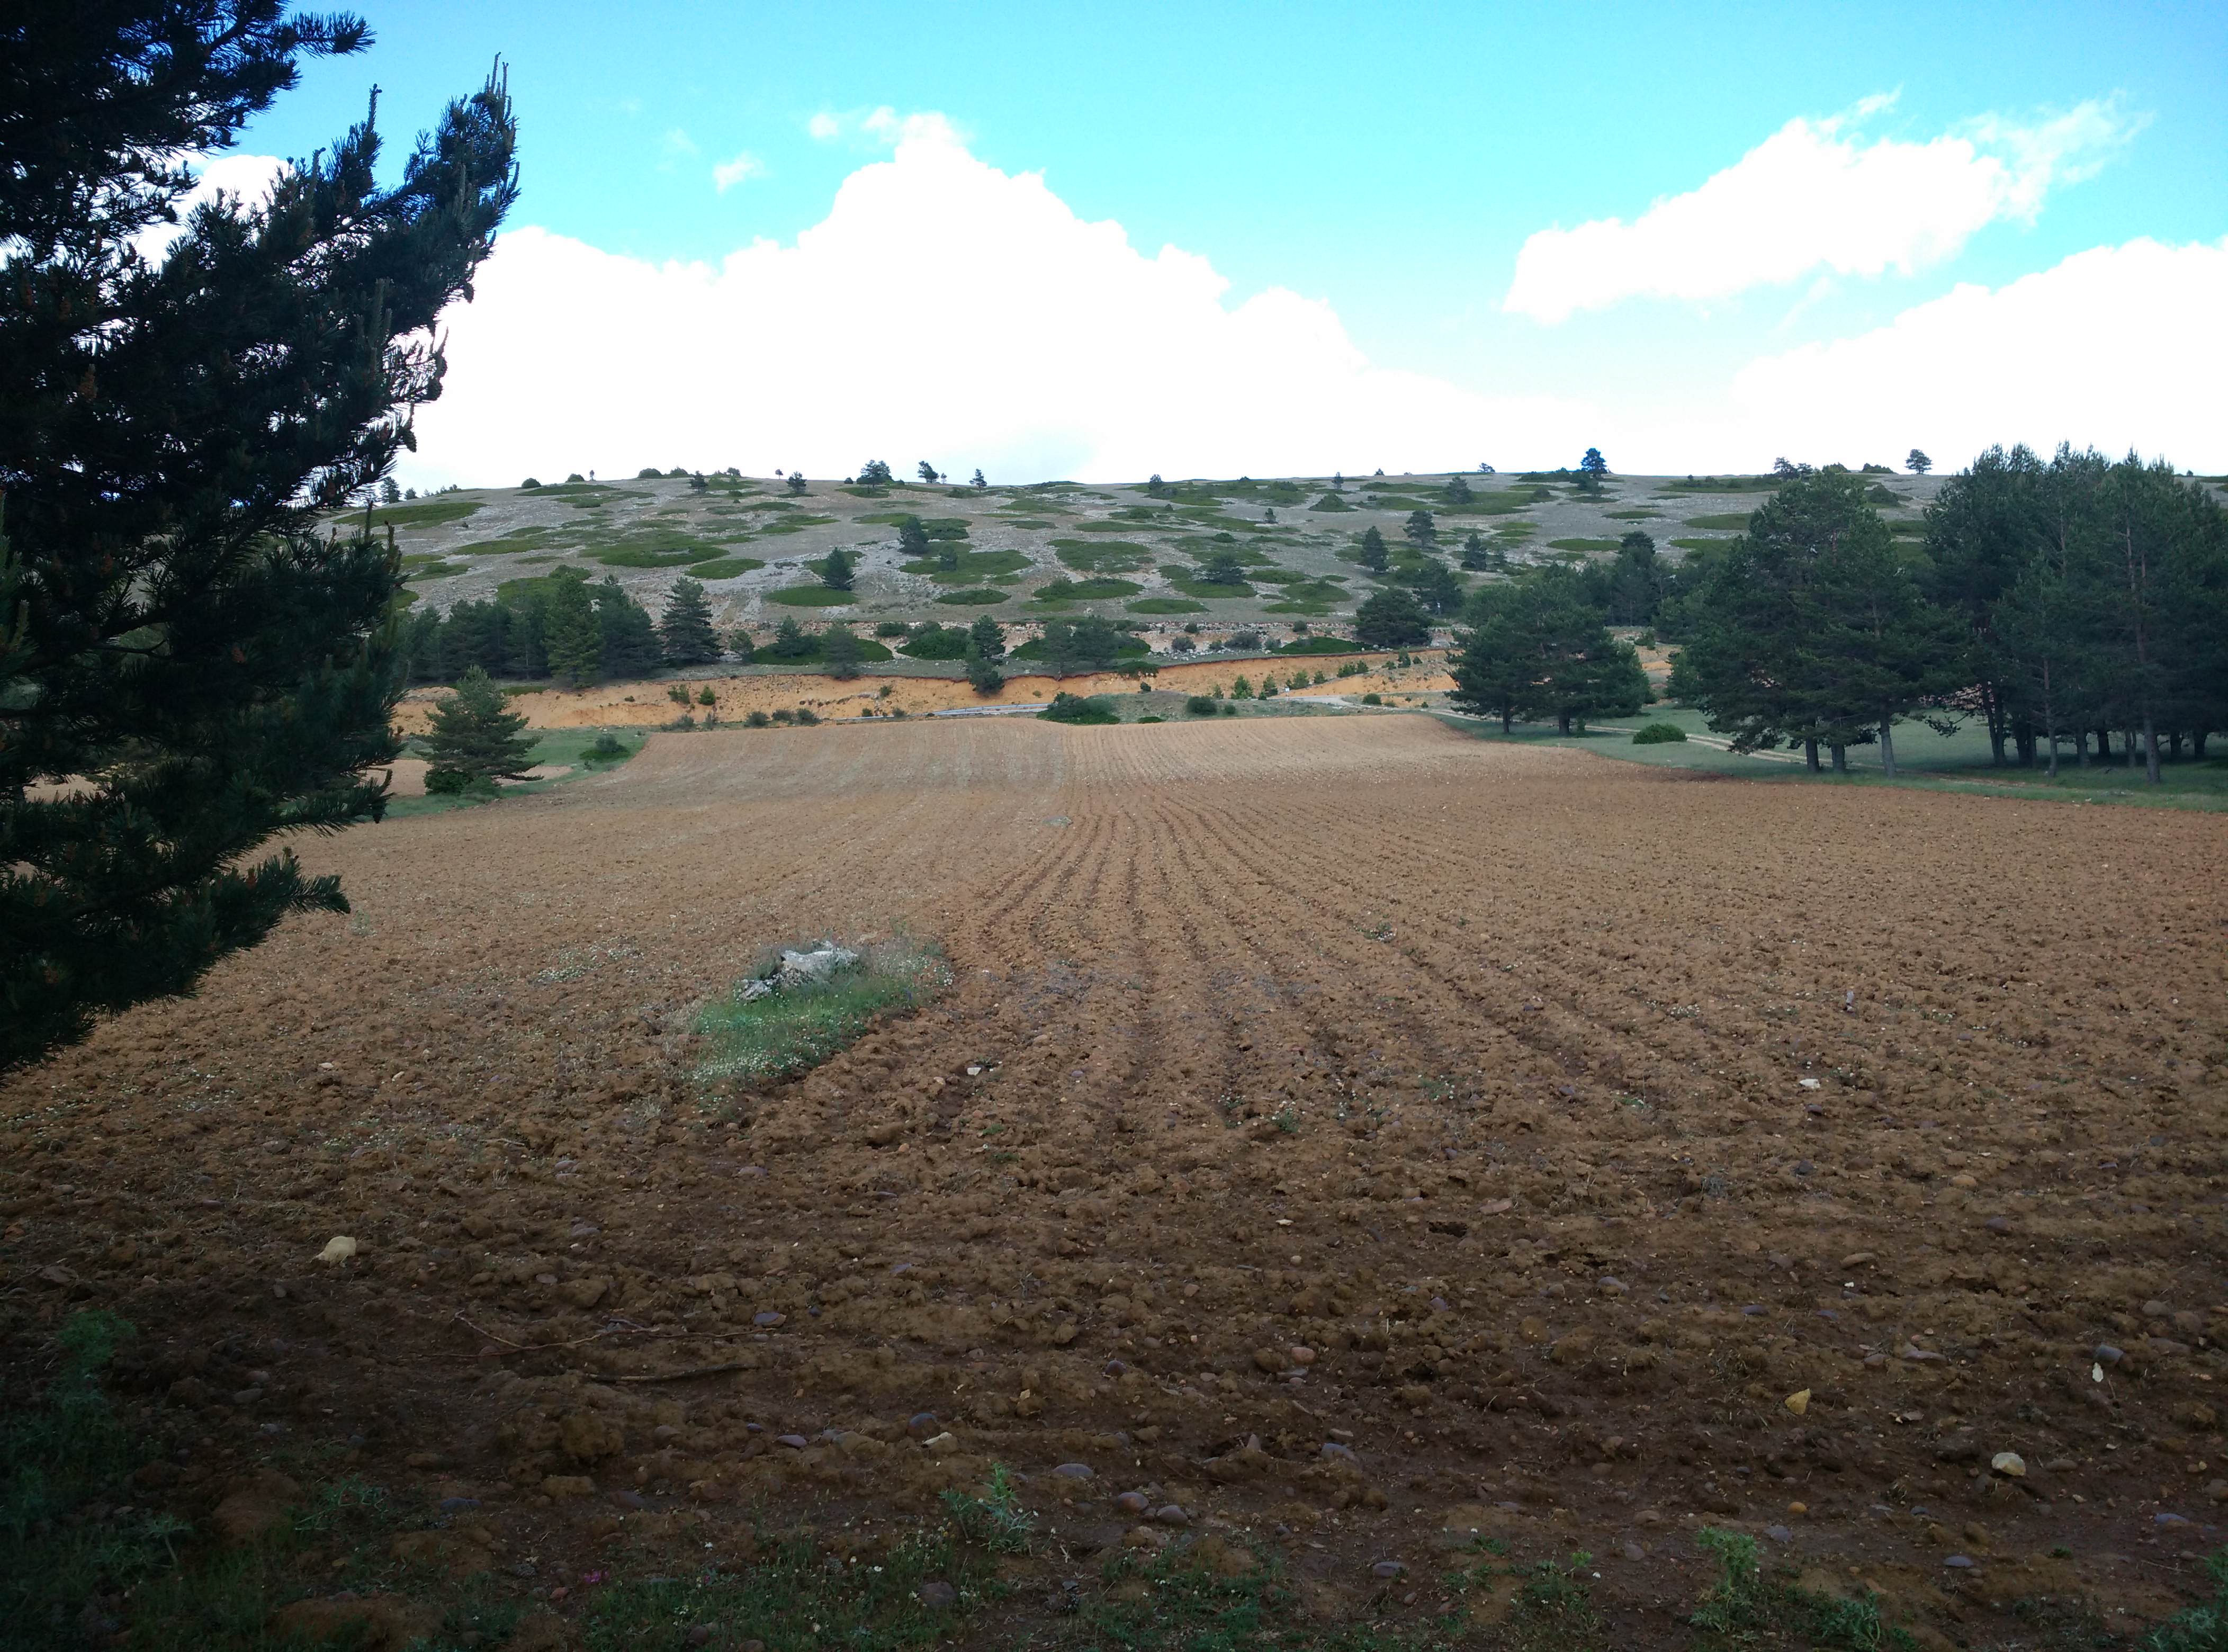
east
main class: Woodland
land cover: Pine dominated coniferous woodland
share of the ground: 25 - 50 %
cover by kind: herbaceous plants 45 %, coniferous forest trees 25 %, unconsolidated bare surface 25 %, lichens and mosses 5 %
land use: Semi-natural and natural areas not in use
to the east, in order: Pine dominated coniferous woodland; Other bare soil; Grassland with sparse tree/shrub cover; Paved roads, cycling and walking lanes; Grassland with sparse tree/shrub cover
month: June
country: ES
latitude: 40.3341
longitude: -1.6797
